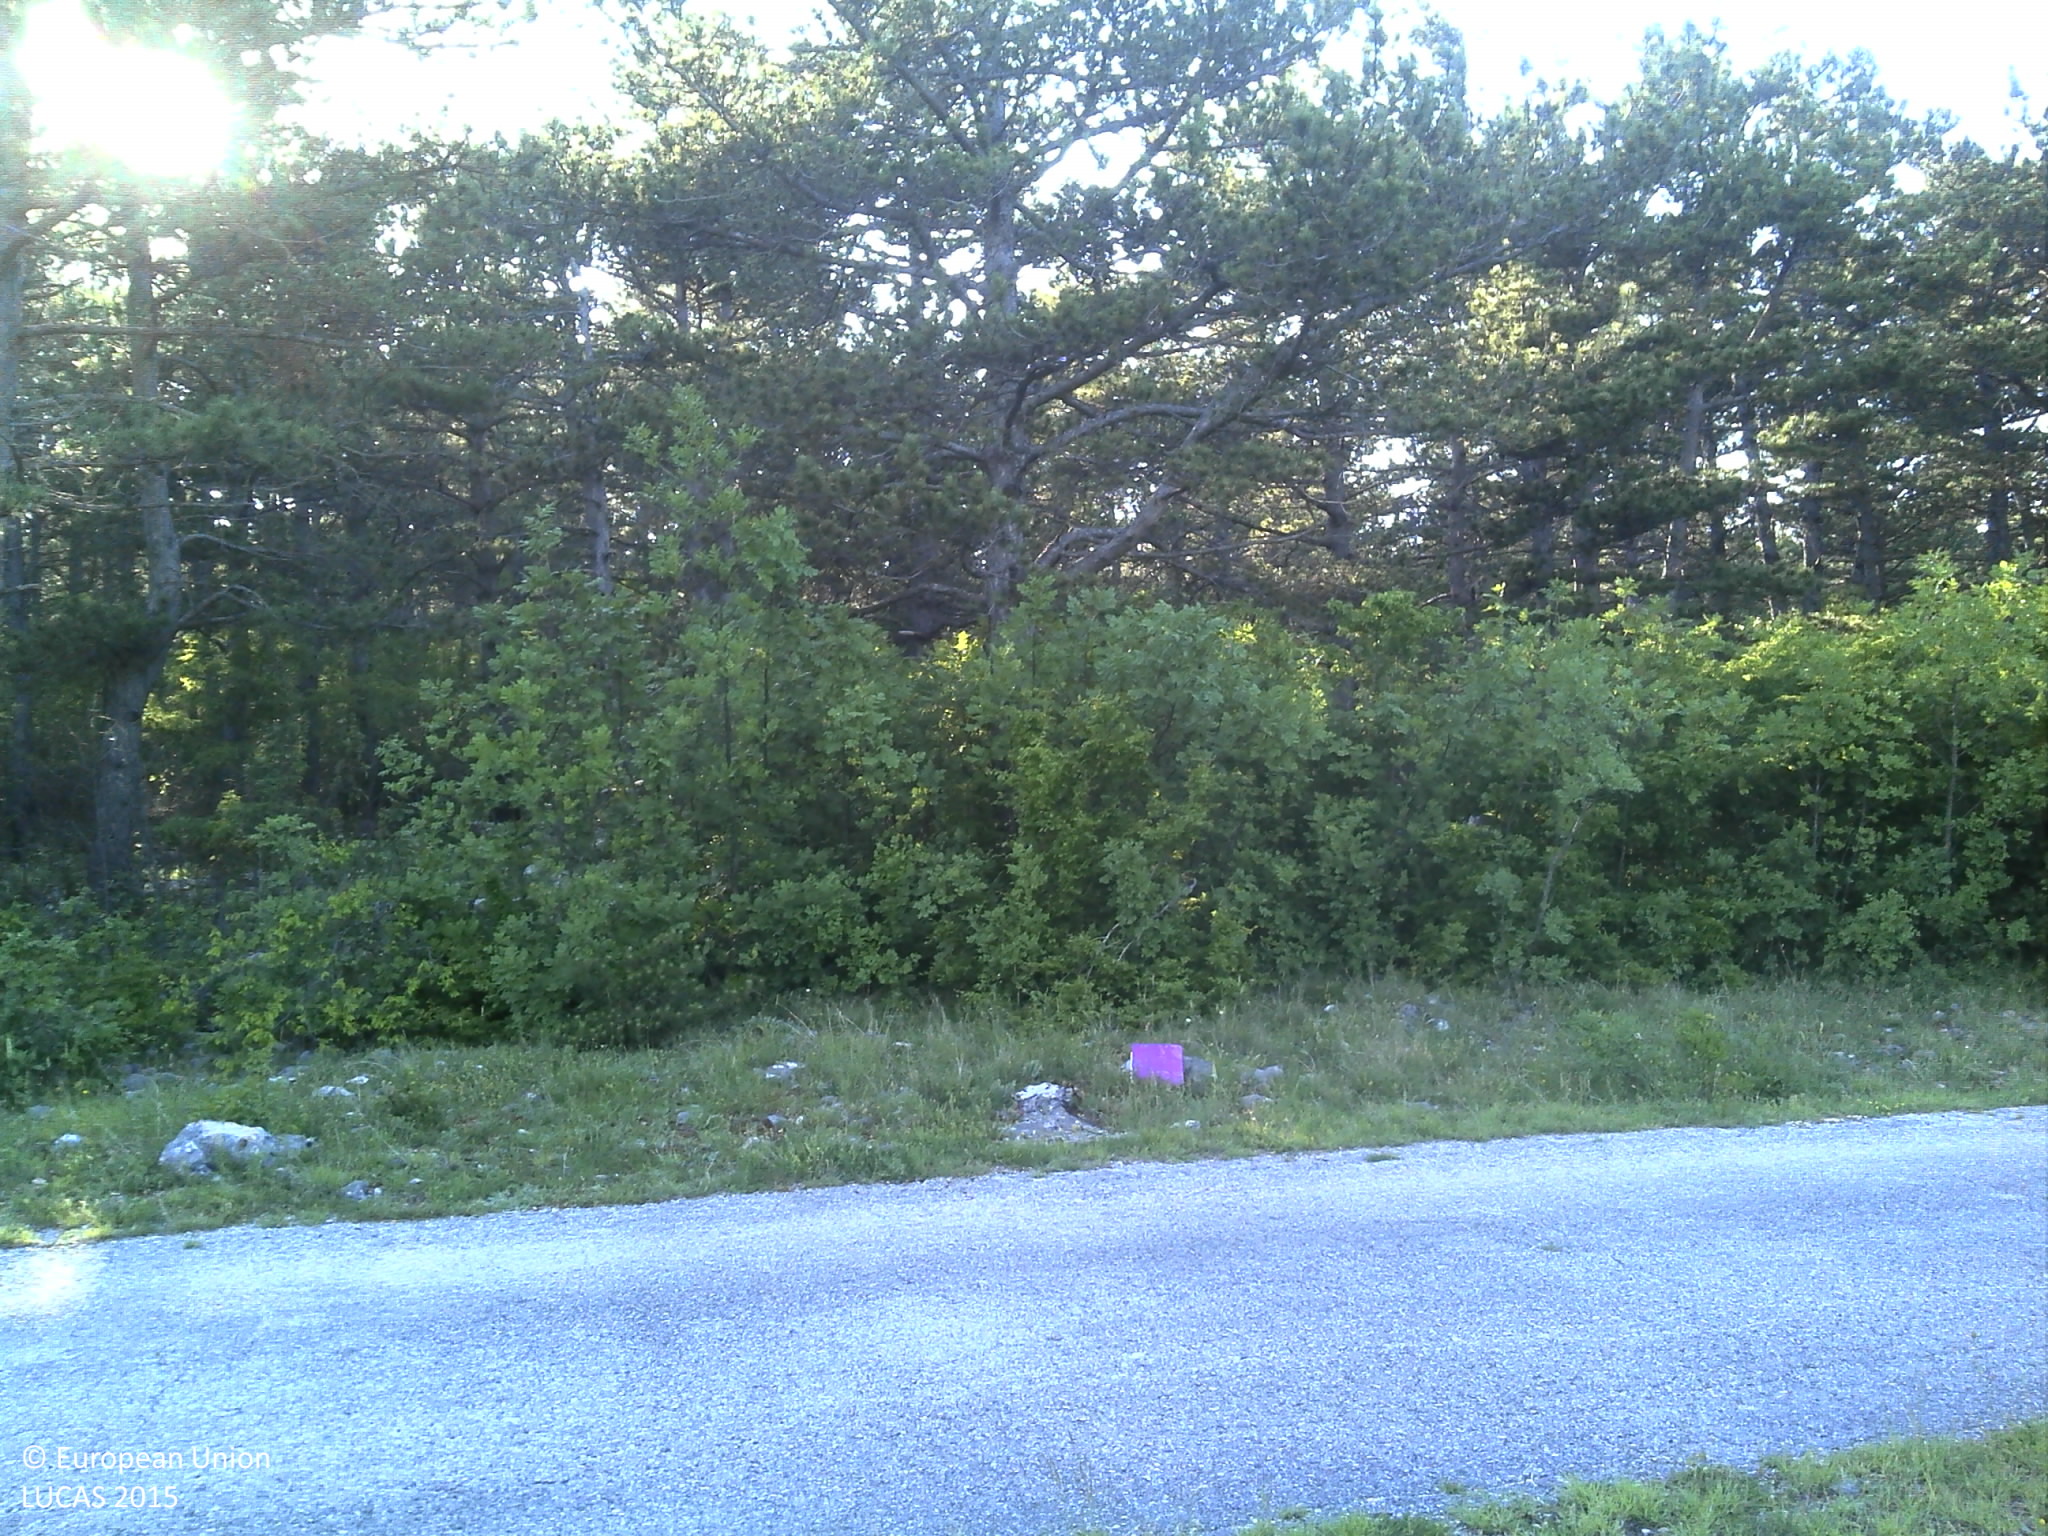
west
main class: Woodland
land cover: Pine dominated coniferous woodland
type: coniferous forest of the mediterranean region
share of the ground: > 75 %
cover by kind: coniferous forest trees 90 %, shrubs 5 %, herbaceous plants 5 %
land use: Forestry
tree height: > 5 m
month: June
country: HR
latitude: 43.9713
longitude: 16.4120
